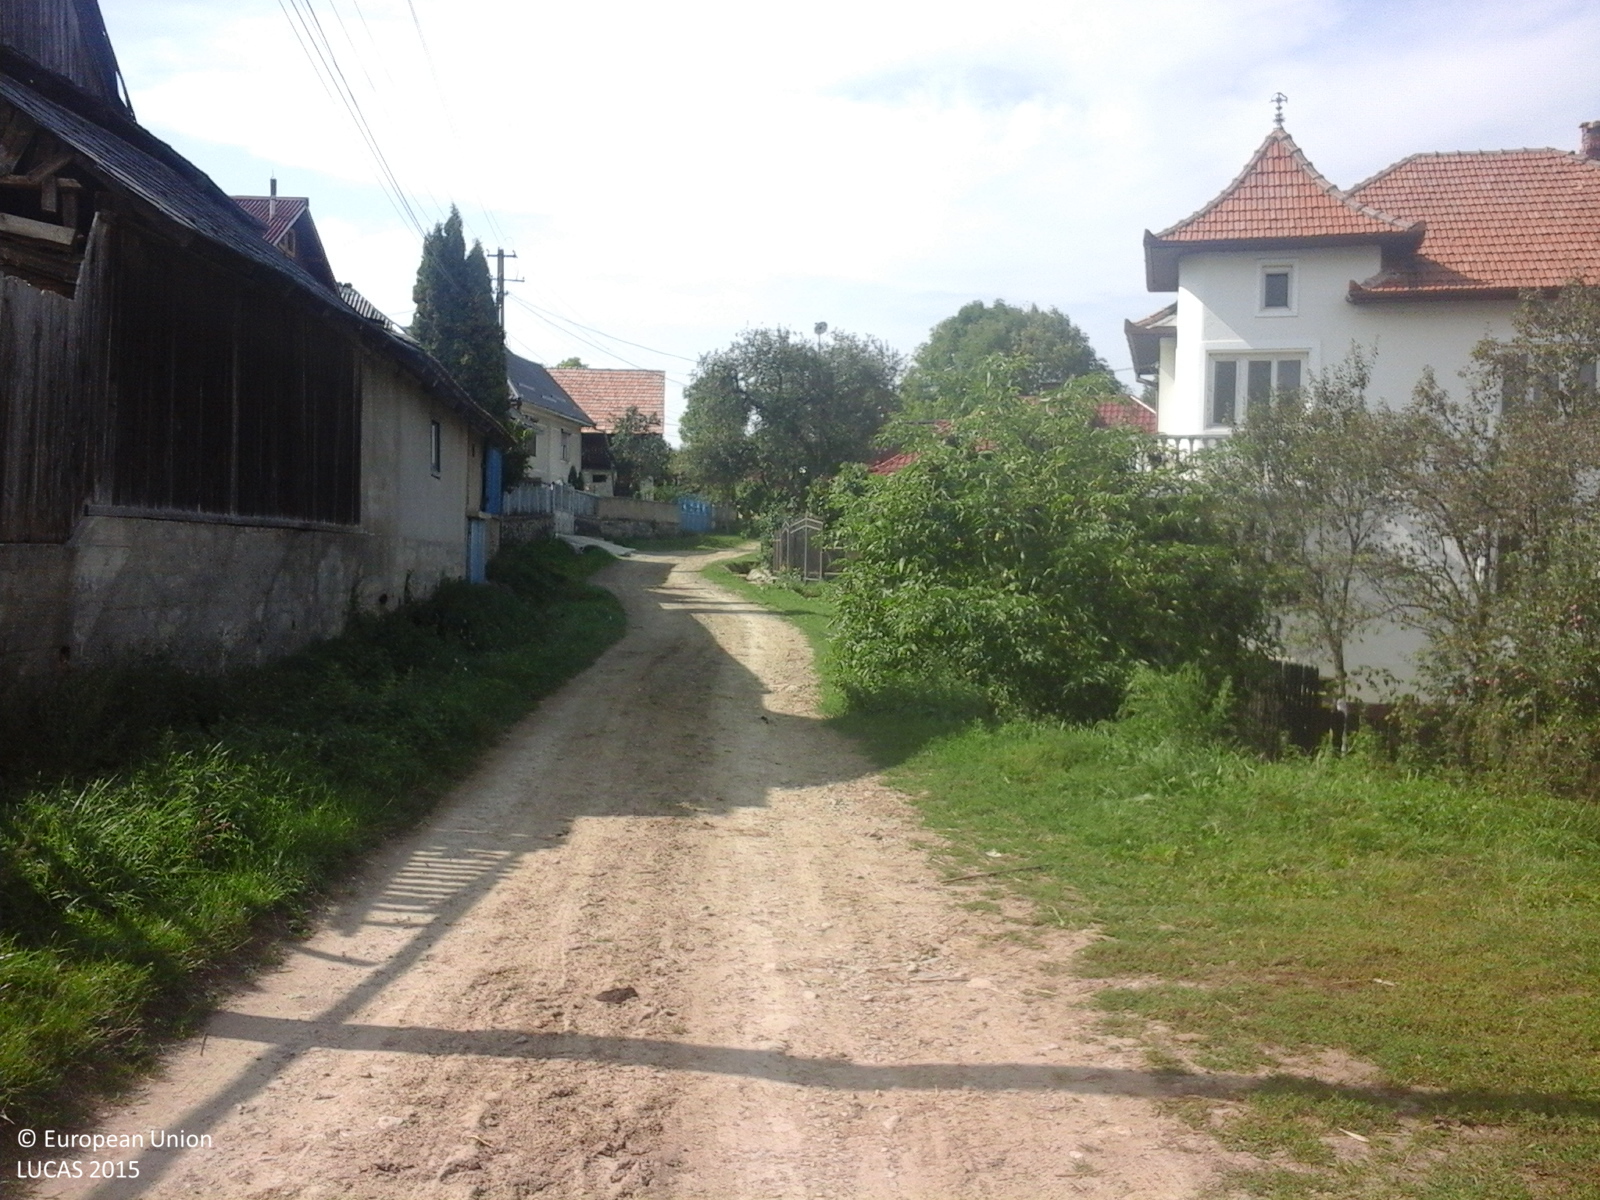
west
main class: Cropland
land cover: Apple fruit
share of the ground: > 75 %
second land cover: Grassland without tree/shrub cover
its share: > 75 %
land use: Agriculture (excluding fallow land and kitchen gardens)
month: September
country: RO
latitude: 46.8079
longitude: 23.1815
